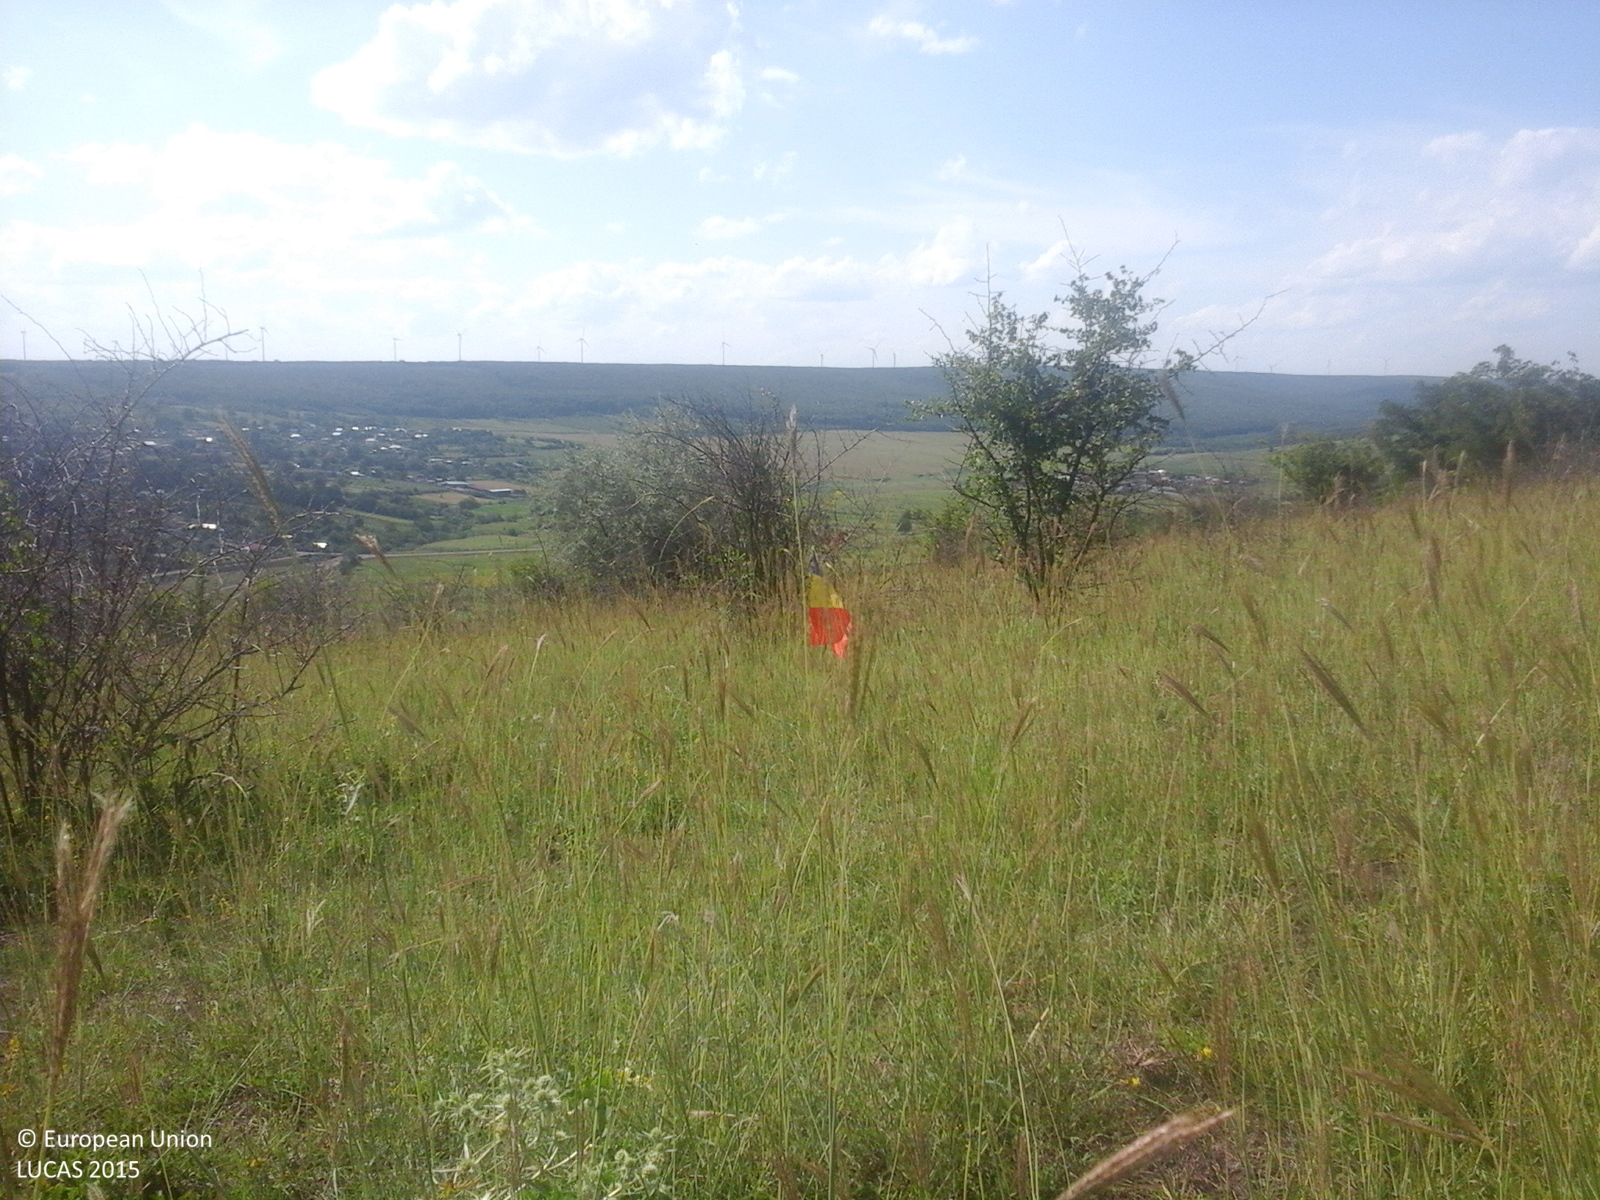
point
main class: Grassland
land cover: Grassland with sparse tree/shrub cover
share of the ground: > 75 %
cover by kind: herbaceous plants 85 %, shrubs 10 %, broadleaved forest trees 5 %
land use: Agriculture (excluding fallow land and kitchen gardens)
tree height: < 5 m
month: July
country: RO
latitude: 46.4879
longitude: 27.9864
